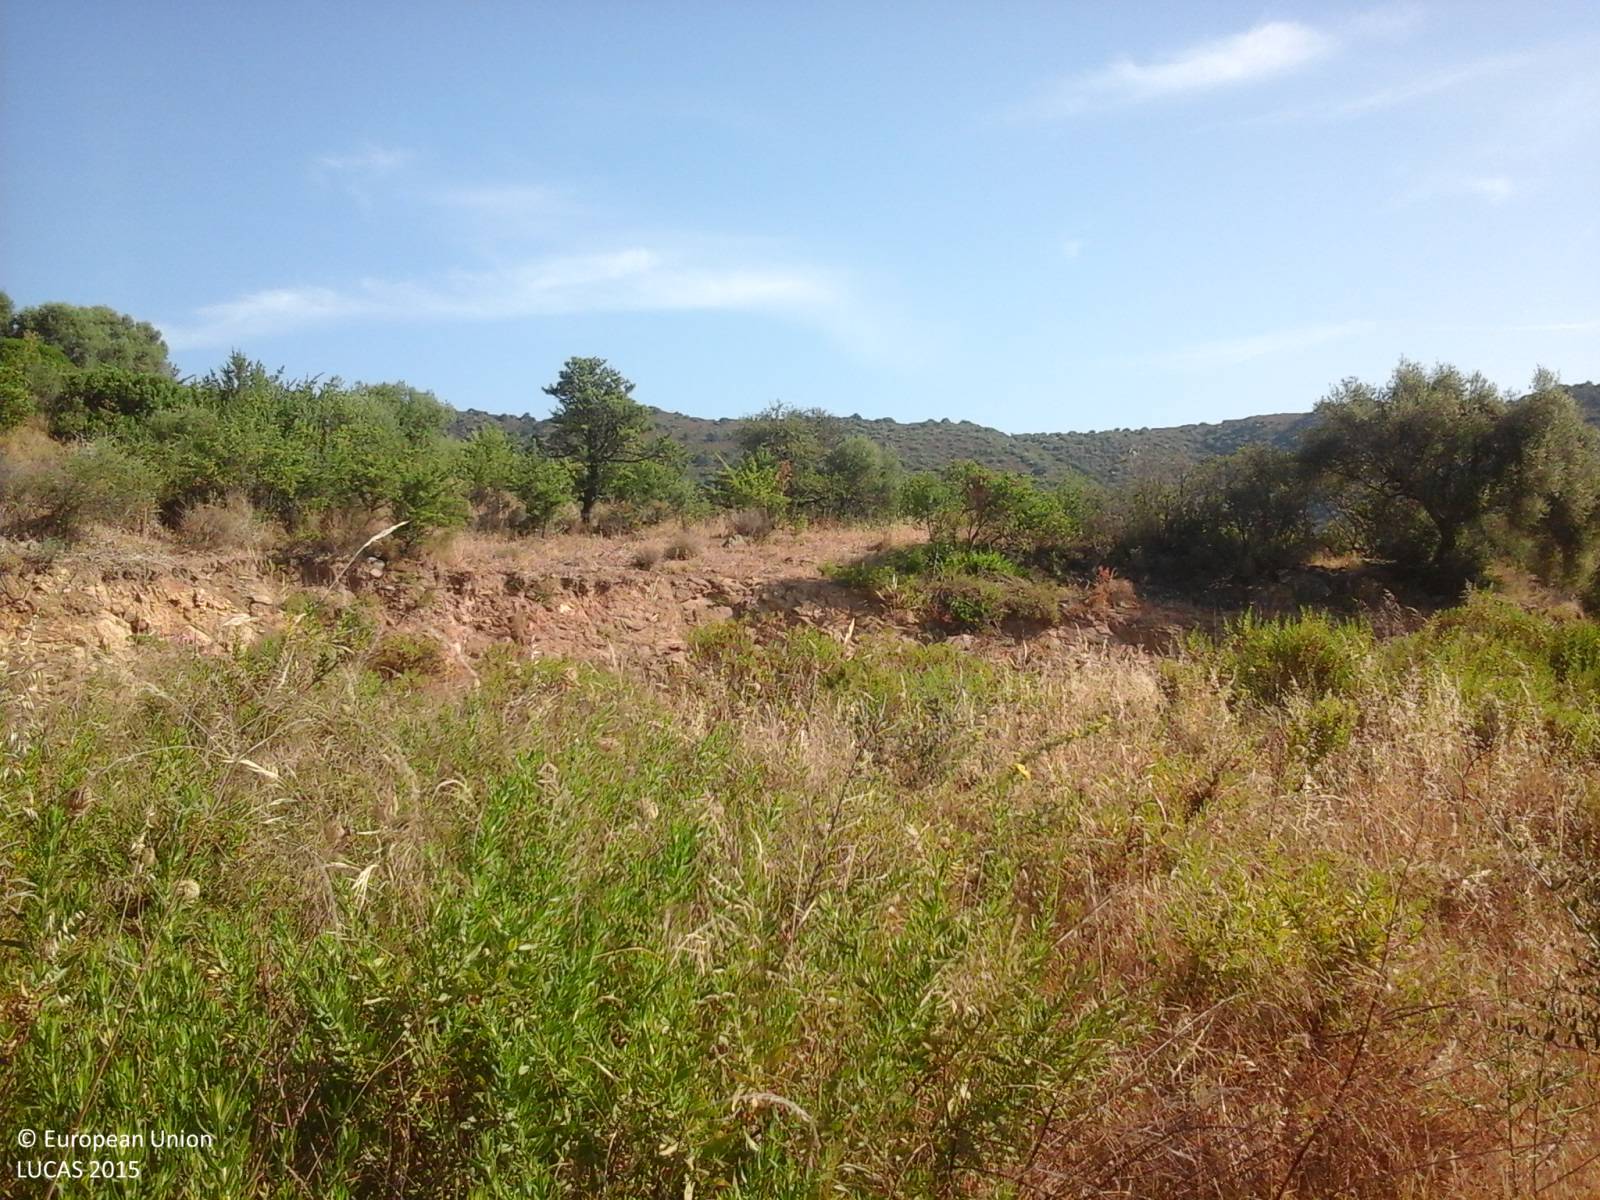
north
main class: Shrubland
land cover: Shrubland without tree cover
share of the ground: > 75 %
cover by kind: shrubs 85 %, unconsolidated bare surface 10 %, herbaceous plants 5 %
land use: Semi-natural and natural areas not in use
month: June
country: IT
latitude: 40.6469
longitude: 9.6823
